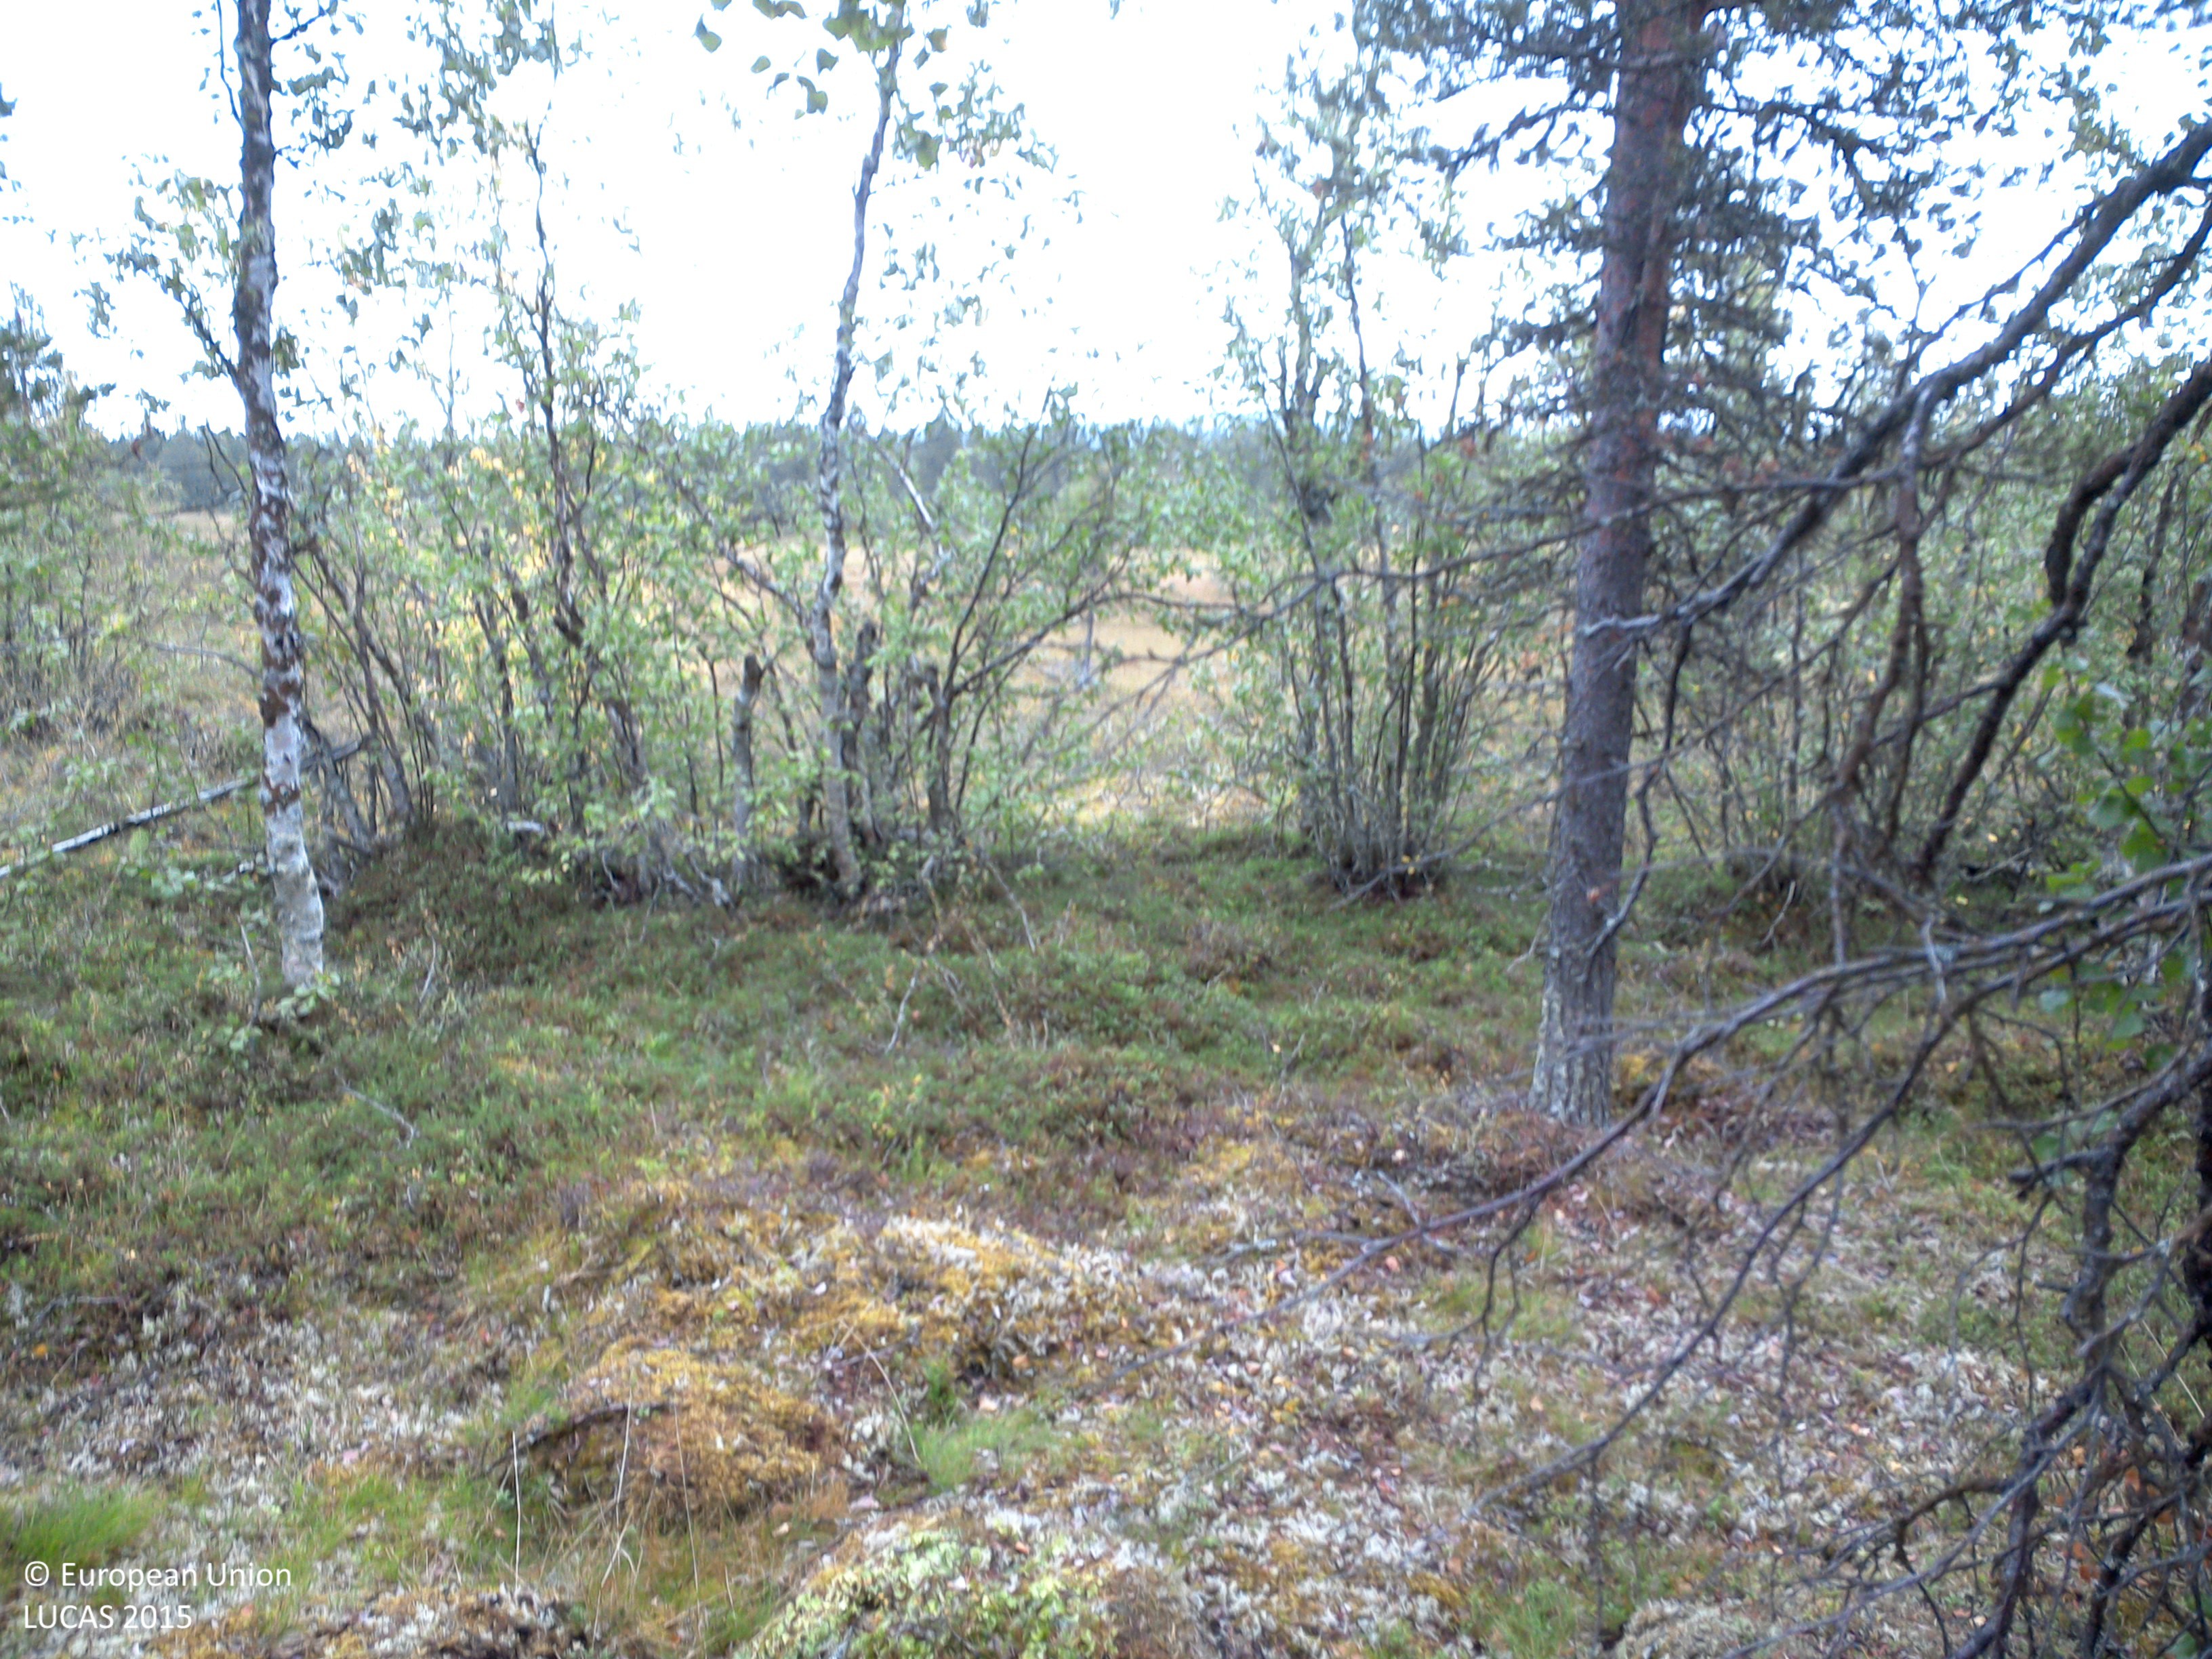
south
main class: Woodland
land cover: Pine dominated mixed woodland
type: boreal forest
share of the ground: 25 - 50 %
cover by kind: shrubs 50 %, lichens and mosses 25 %, coniferous forest trees 15 %, broadleaved forest trees 10 %
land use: Amenities, museums, leisure
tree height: > 5 m
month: August
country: SE
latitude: 67.9838
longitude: 21.6330
